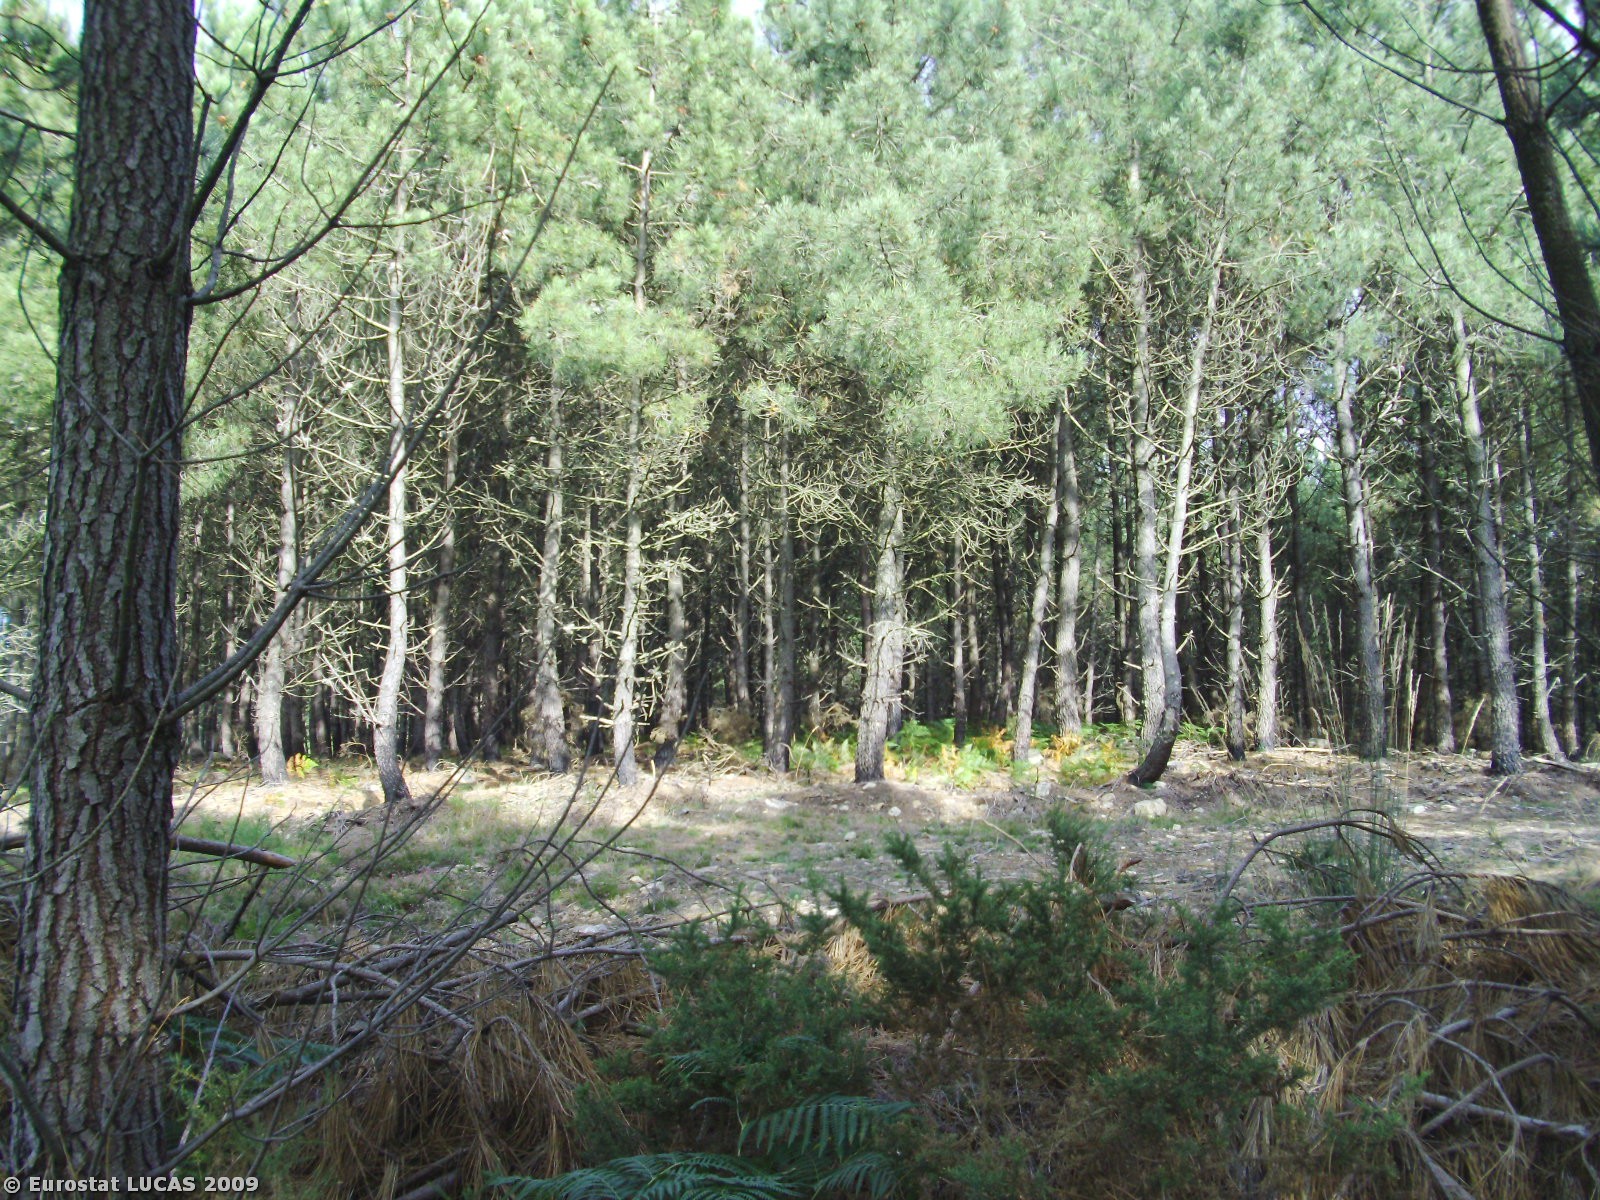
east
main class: Woodland
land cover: Coniferous woodland
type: coniferous forest of the mediterranean region
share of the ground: > 75 %
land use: Forestry
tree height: > 5 m
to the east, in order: Coniferous woodland; Bare land; Coniferous woodland; Dry stone walls; Spontaneously vegetated surfaces; Dry stone walls; Spontaneously vegetated surfaces
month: July
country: PT
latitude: 41.8722
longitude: -8.6113
